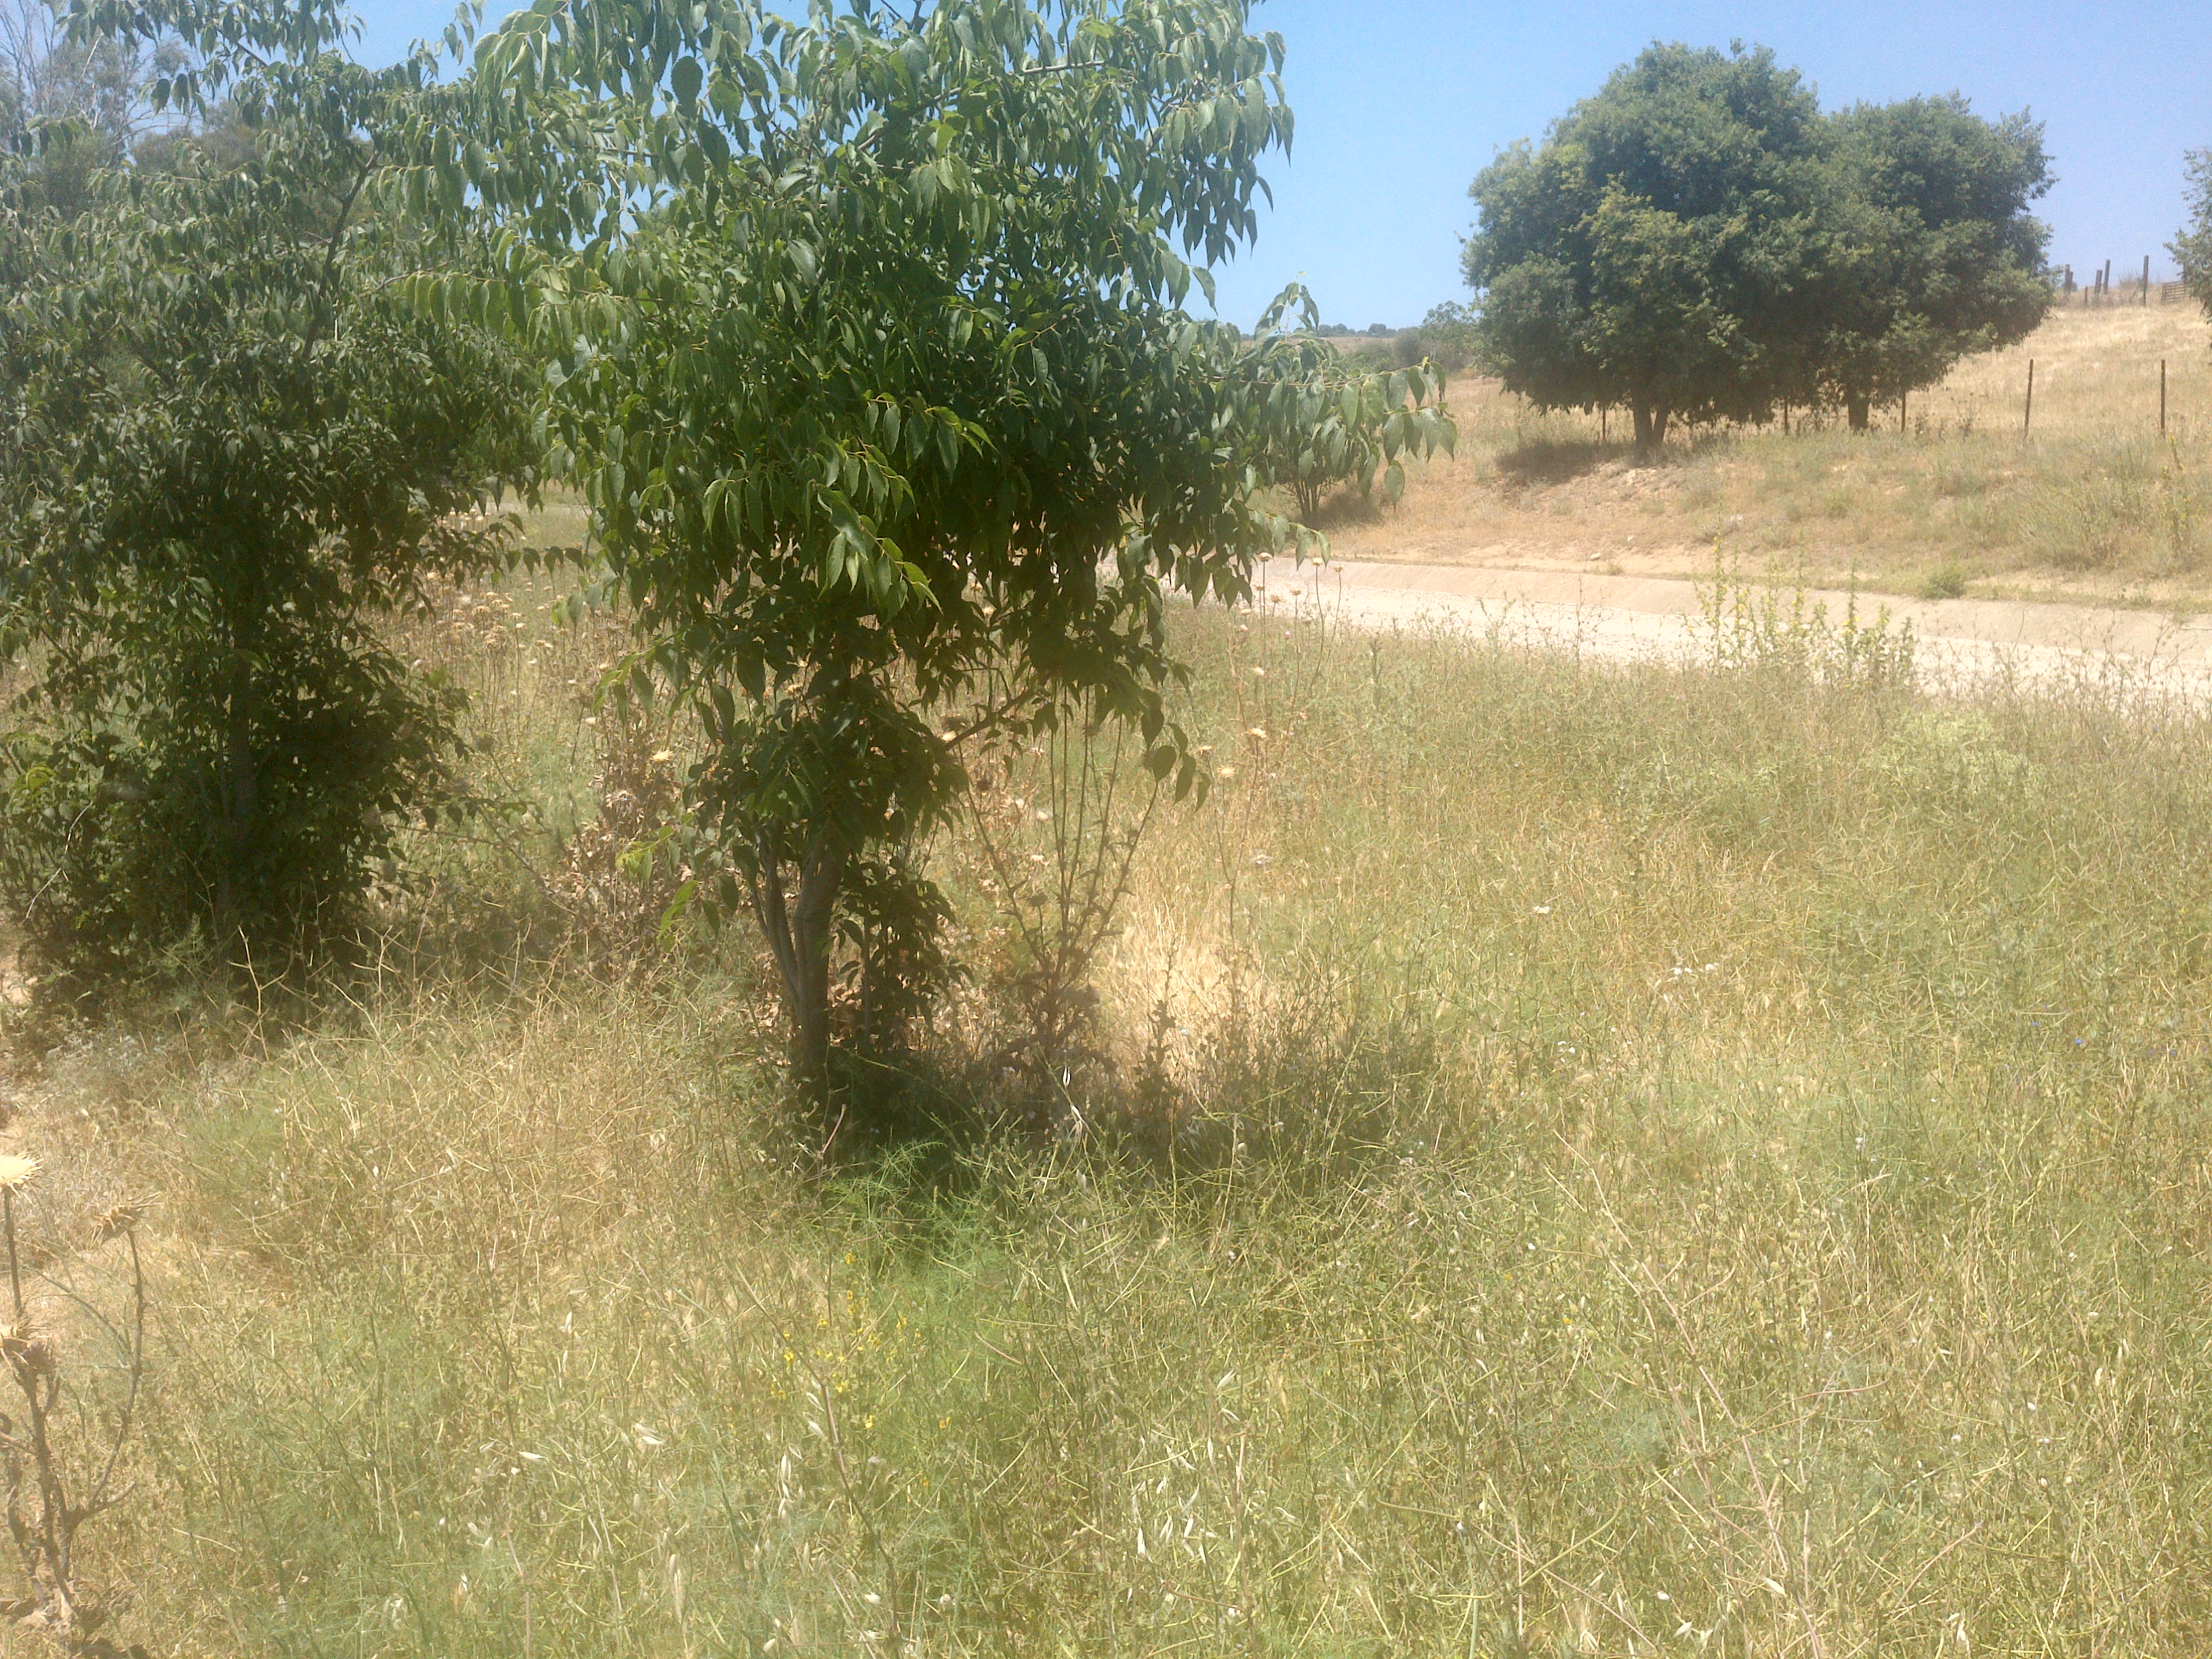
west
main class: Cropland
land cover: Maize
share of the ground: > 75 %
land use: Agriculture (excluding fallow land and kitchen gardens)
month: May
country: ES
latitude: 37.8697
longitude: -4.9193
